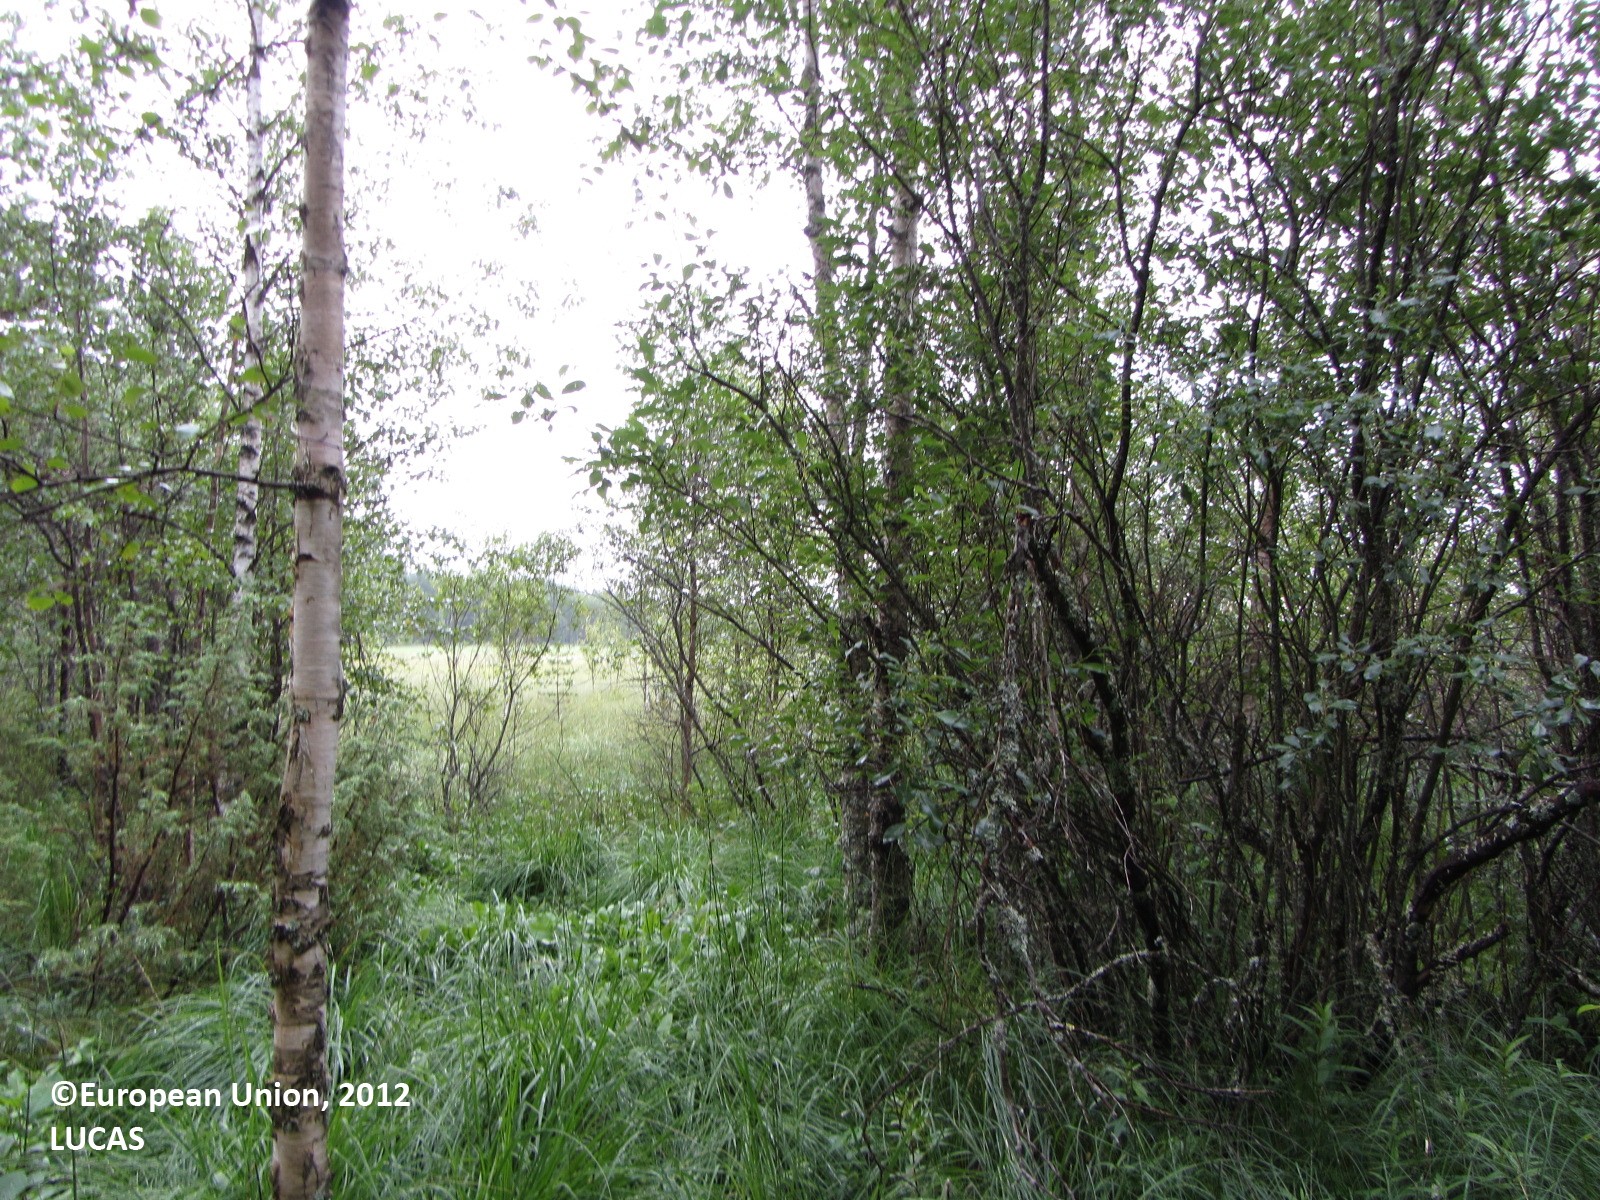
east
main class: Woodland
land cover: Broadleaved woodland
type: mire and swamp forests
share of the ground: 50 - 75 %
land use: Semi-natural and natural areas not in use
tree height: > 5 m
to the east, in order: Broadleaved woodland; Inland marshes; Pine dominated coniferous woodland; Tracks; Pine dominated coniferous woodland
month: July
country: FI
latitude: 63.8792
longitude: 24.8424
